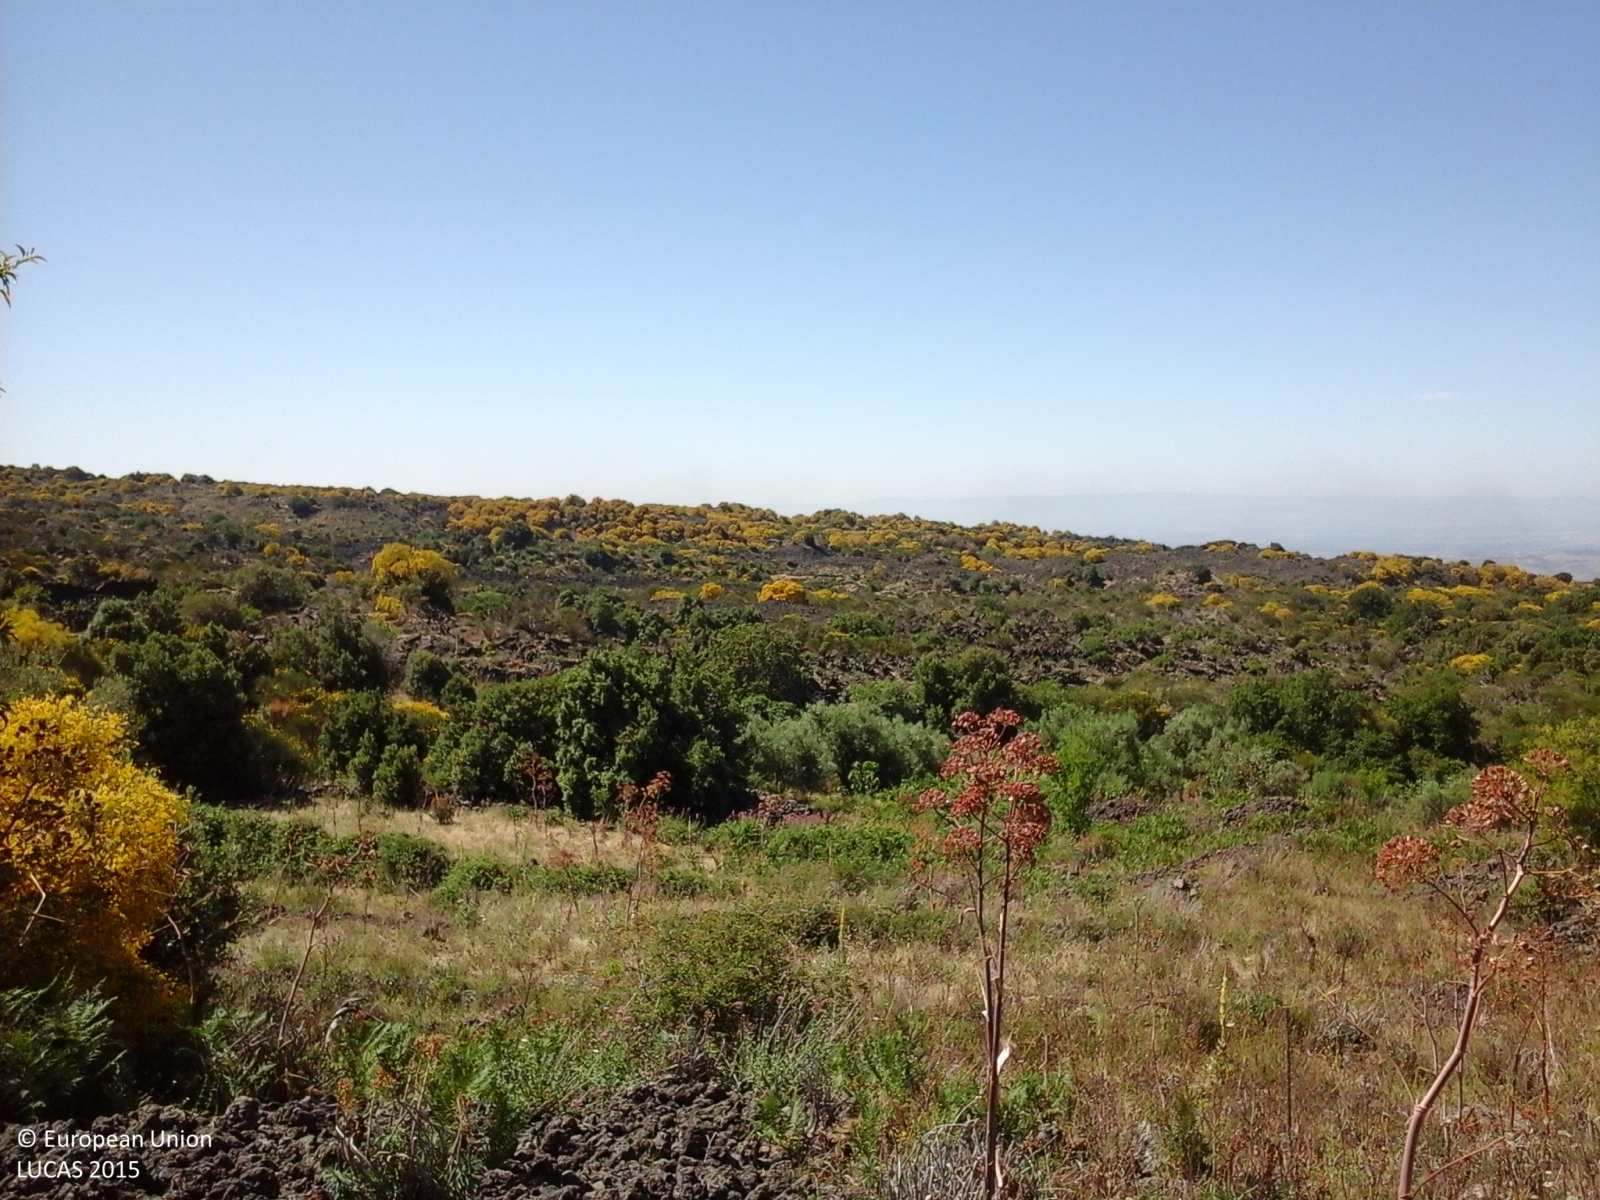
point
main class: Shrubland
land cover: Shrubland with sparse tree cover
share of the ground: > 75 %
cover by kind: shrubs 95 %, broadleaved forest trees 5 %
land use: Amenities, museums, leisure
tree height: < 5 m
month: June
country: IT
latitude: 37.6951
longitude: 14.8764
